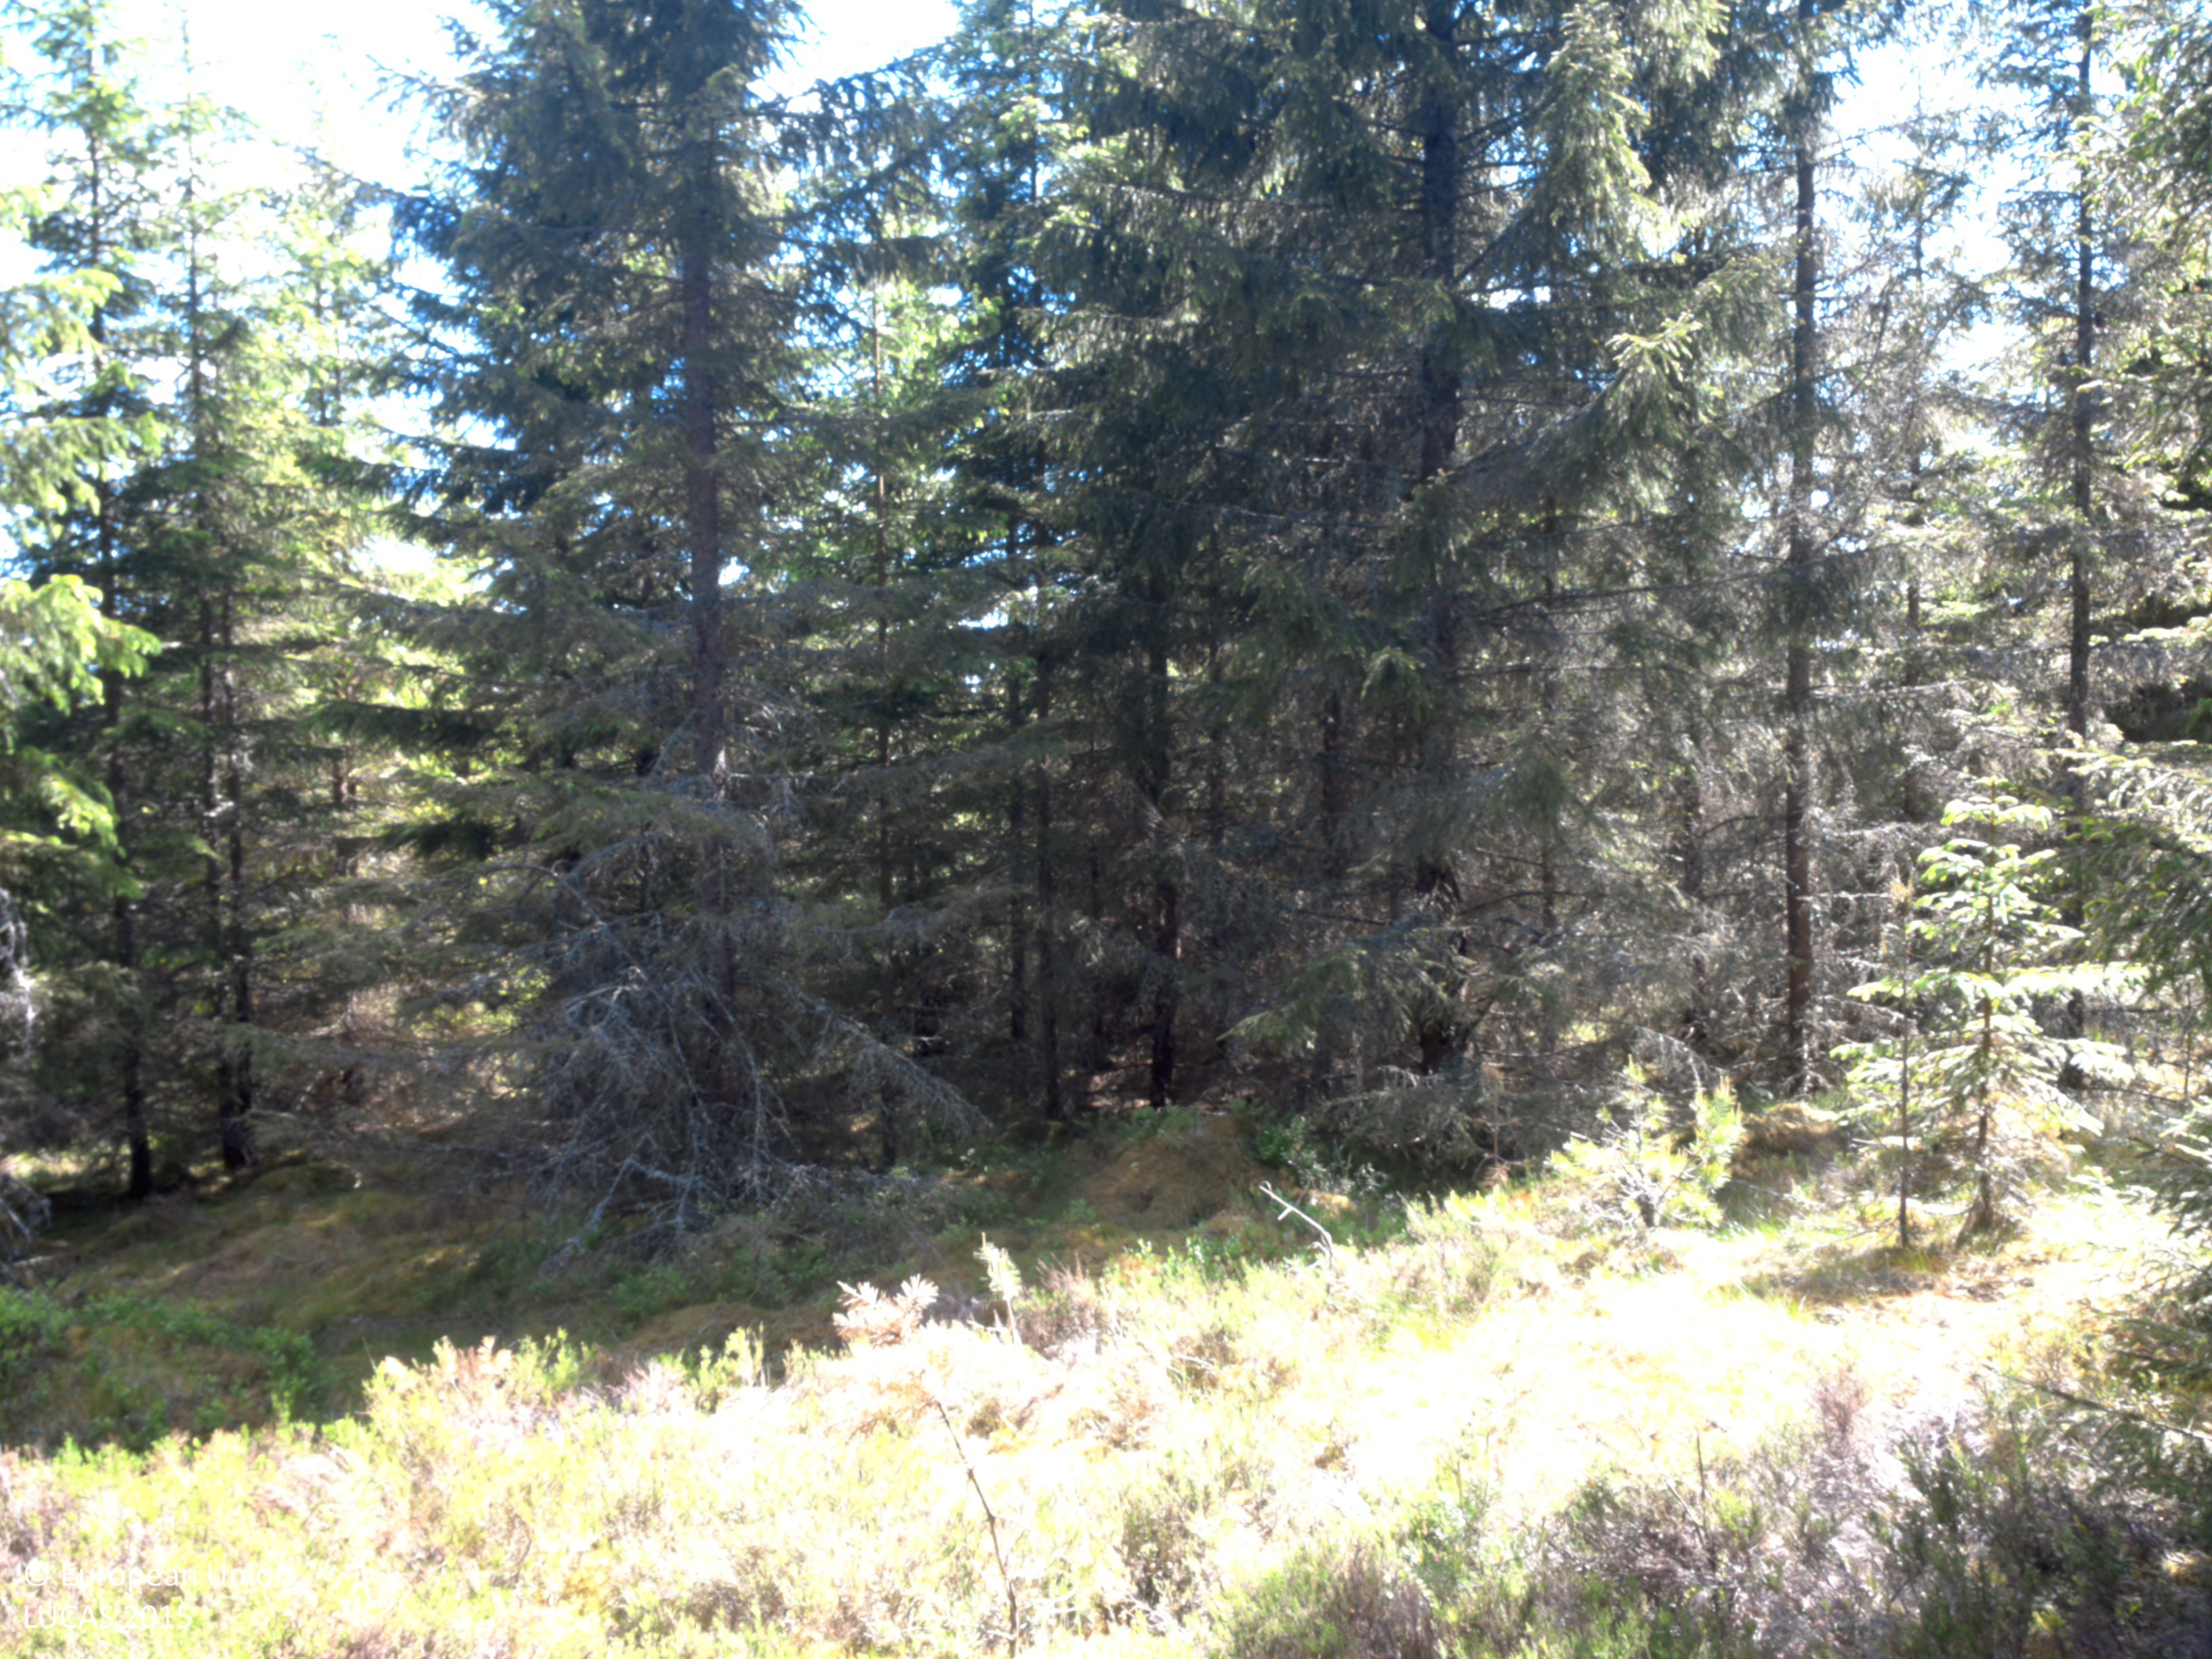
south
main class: Woodland
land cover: Spruce dominated coniferous woodland
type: boreal forest
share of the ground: 25 - 50 %
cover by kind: coniferous forest trees 40 %, shrubs 30 %, lichens and mosses 25 %, herbaceous plants 5 %
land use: Forestry
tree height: > 5 m
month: June
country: SE
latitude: 59.0678
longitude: 12.0358
